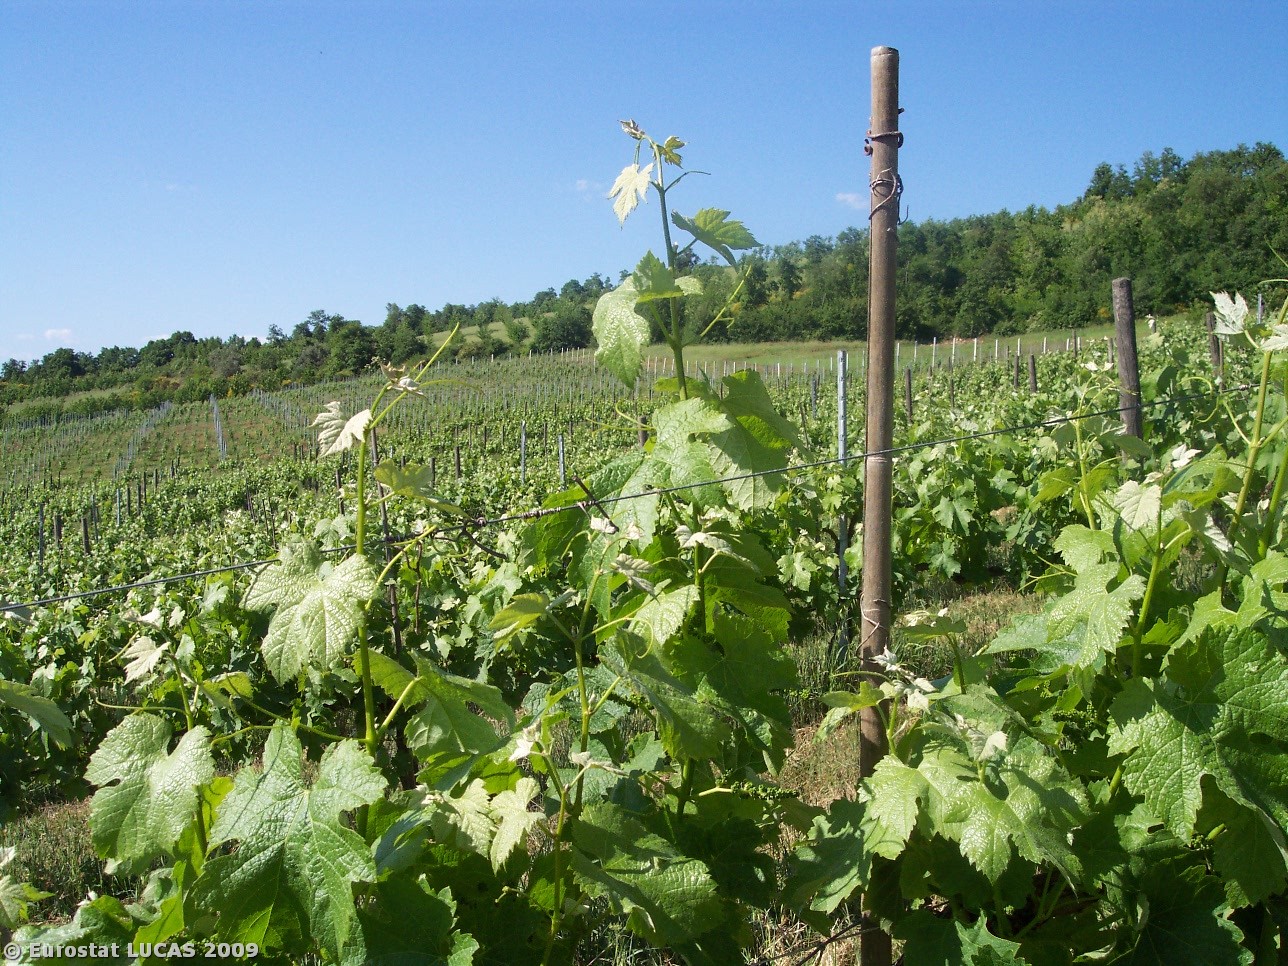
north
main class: Cropland
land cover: Vineyards
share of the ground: 25 - 50 %
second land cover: Grassland with sparse tree/shrub cover
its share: > 75 %
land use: Agriculture (excluding fallow land and kitchen gardens)
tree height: < 5 m
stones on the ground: < 10 %
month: May
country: IT
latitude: 43.2760
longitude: 12.3961
